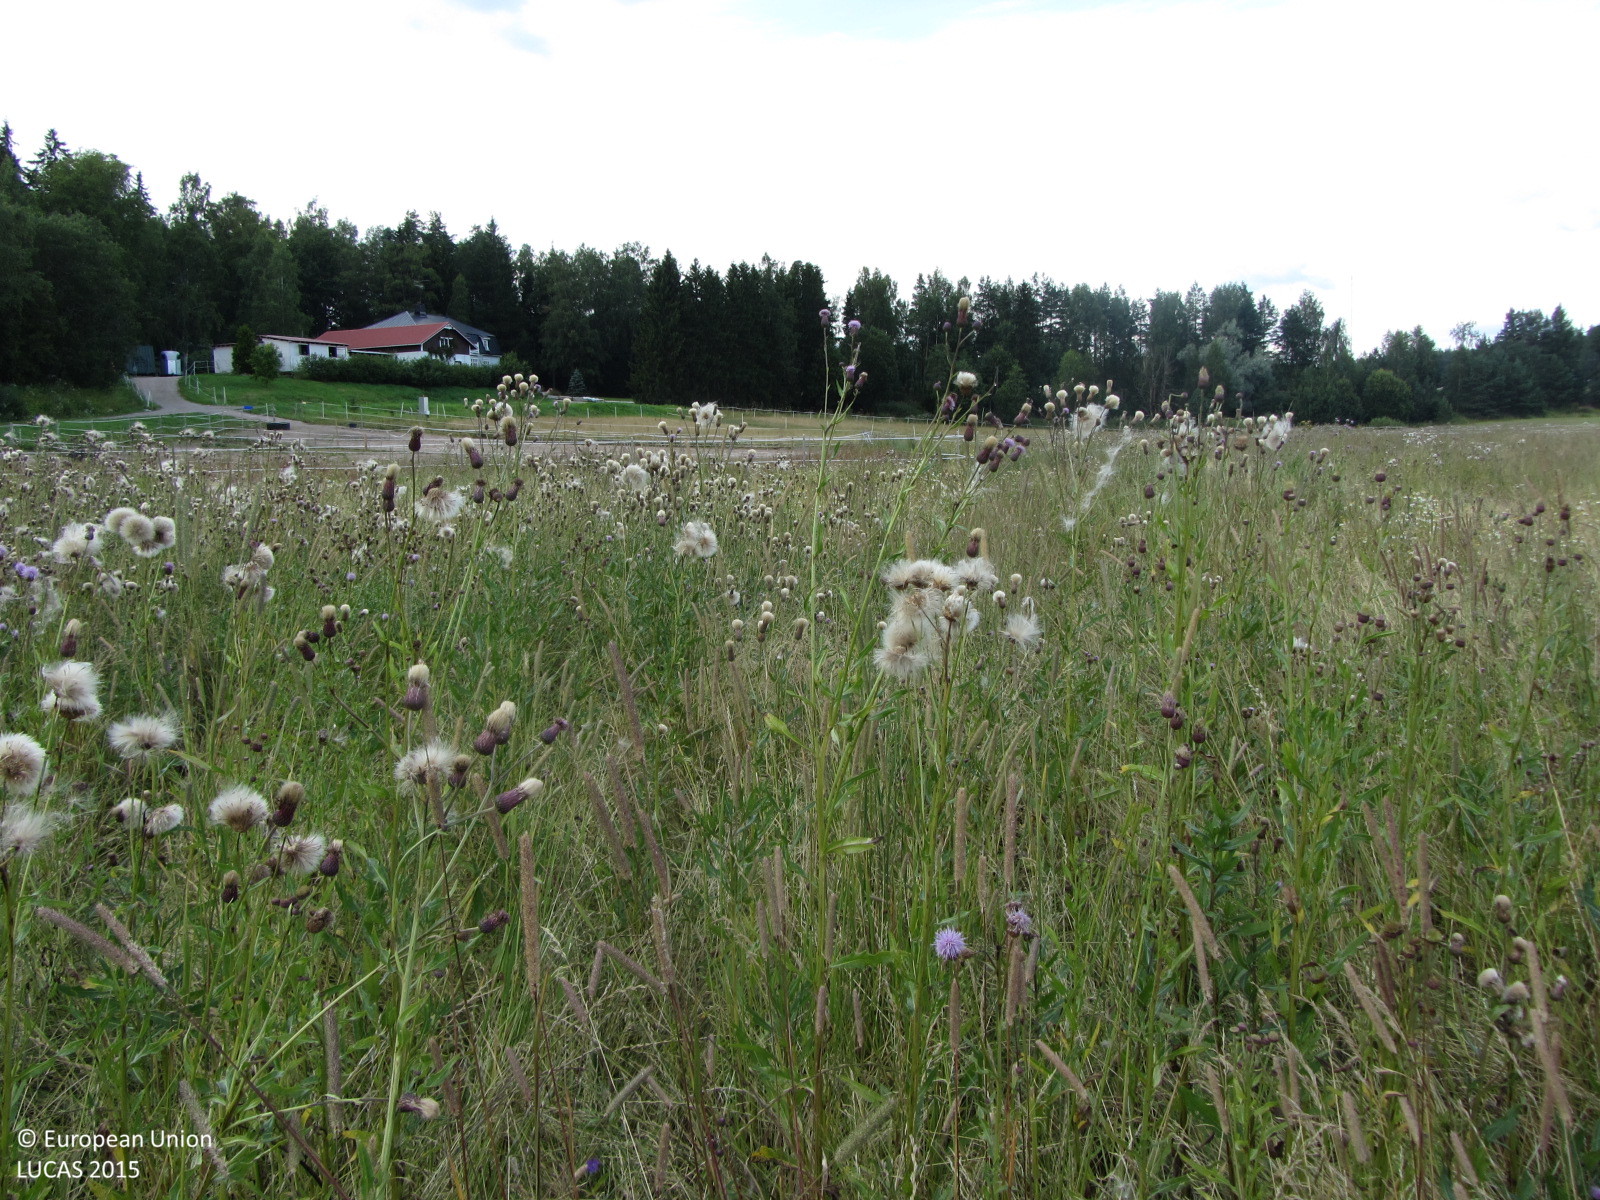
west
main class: Grassland
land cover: Spontaneously vegetated surfaces
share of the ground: > 75 %
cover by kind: herbaceous plants 100 %
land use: Fallow land
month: August
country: FI
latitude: 60.3708
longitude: 23.4880
